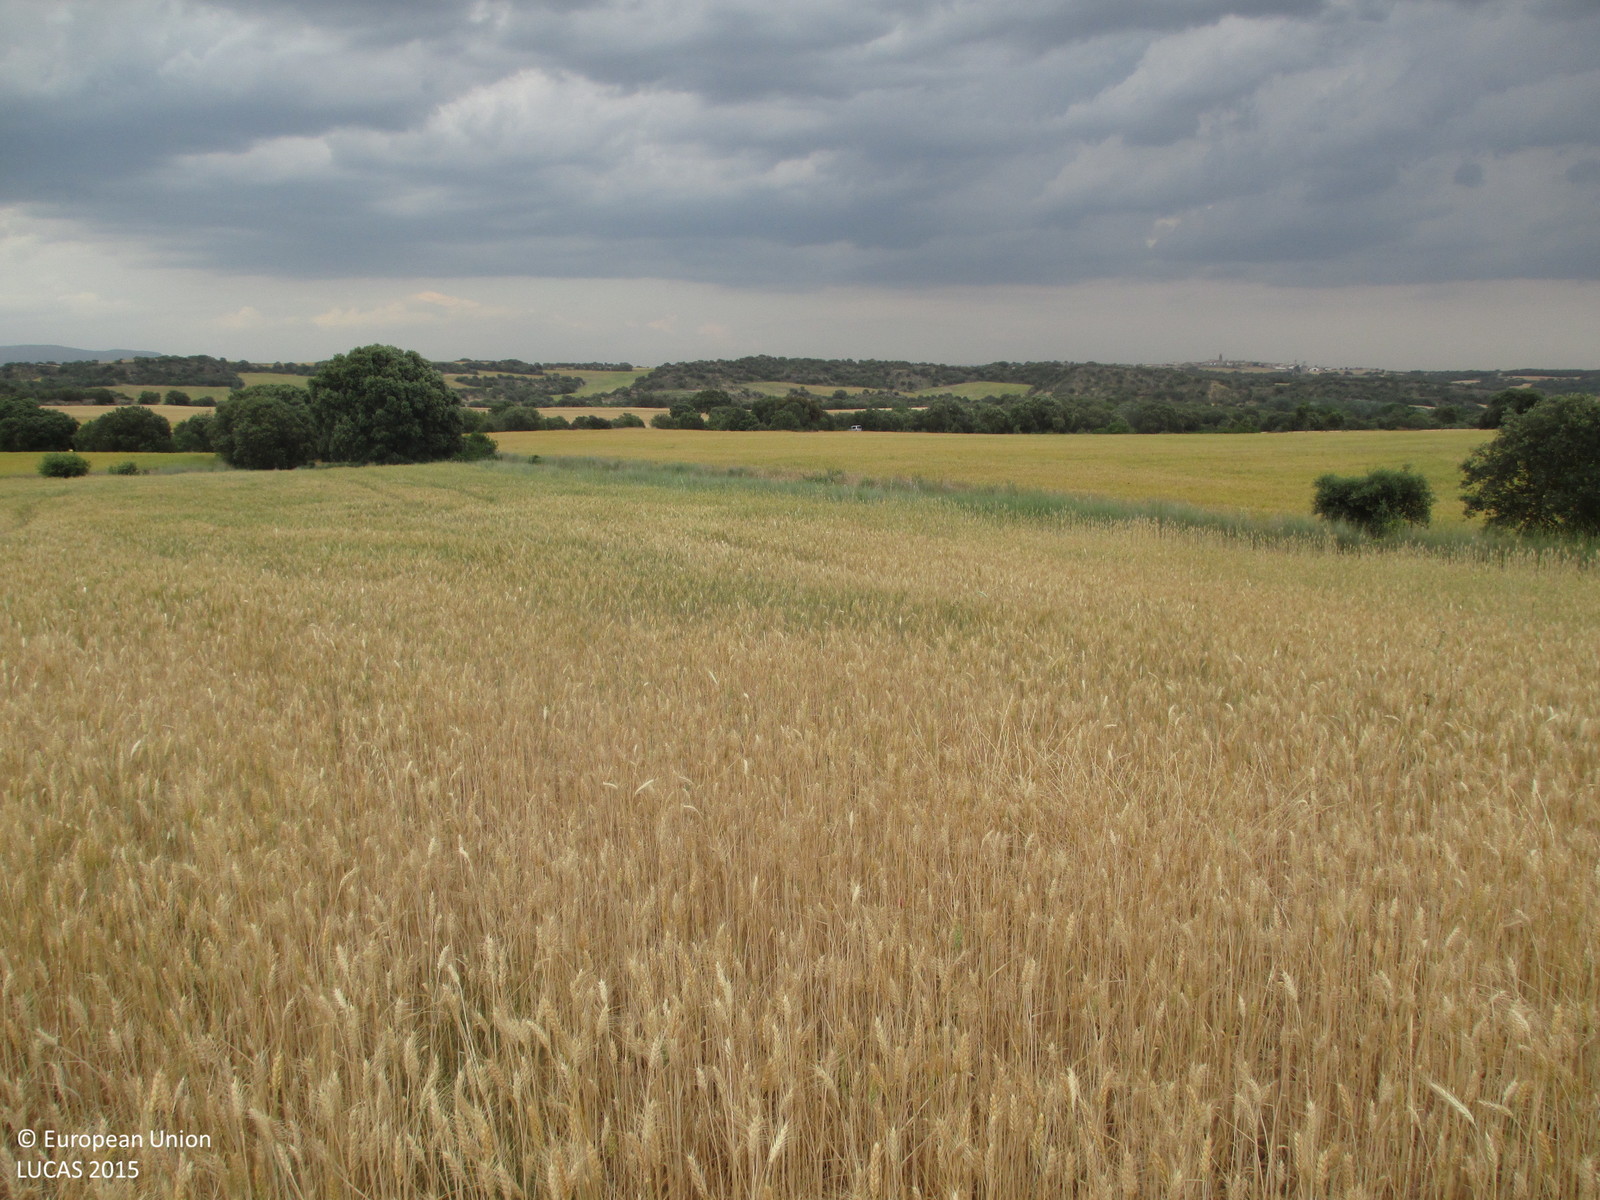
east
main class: Cropland
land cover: Durum wheat
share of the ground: > 75 %
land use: Agriculture (excluding fallow land and kitchen gardens)
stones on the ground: < 10 %
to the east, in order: Durum wheat; Rivers and streams; Grassland without tree/shrub cover; Shruby margins; Barley; Broadleaved woodland; Barley
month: May
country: ES
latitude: 42.1203
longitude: -0.1933
